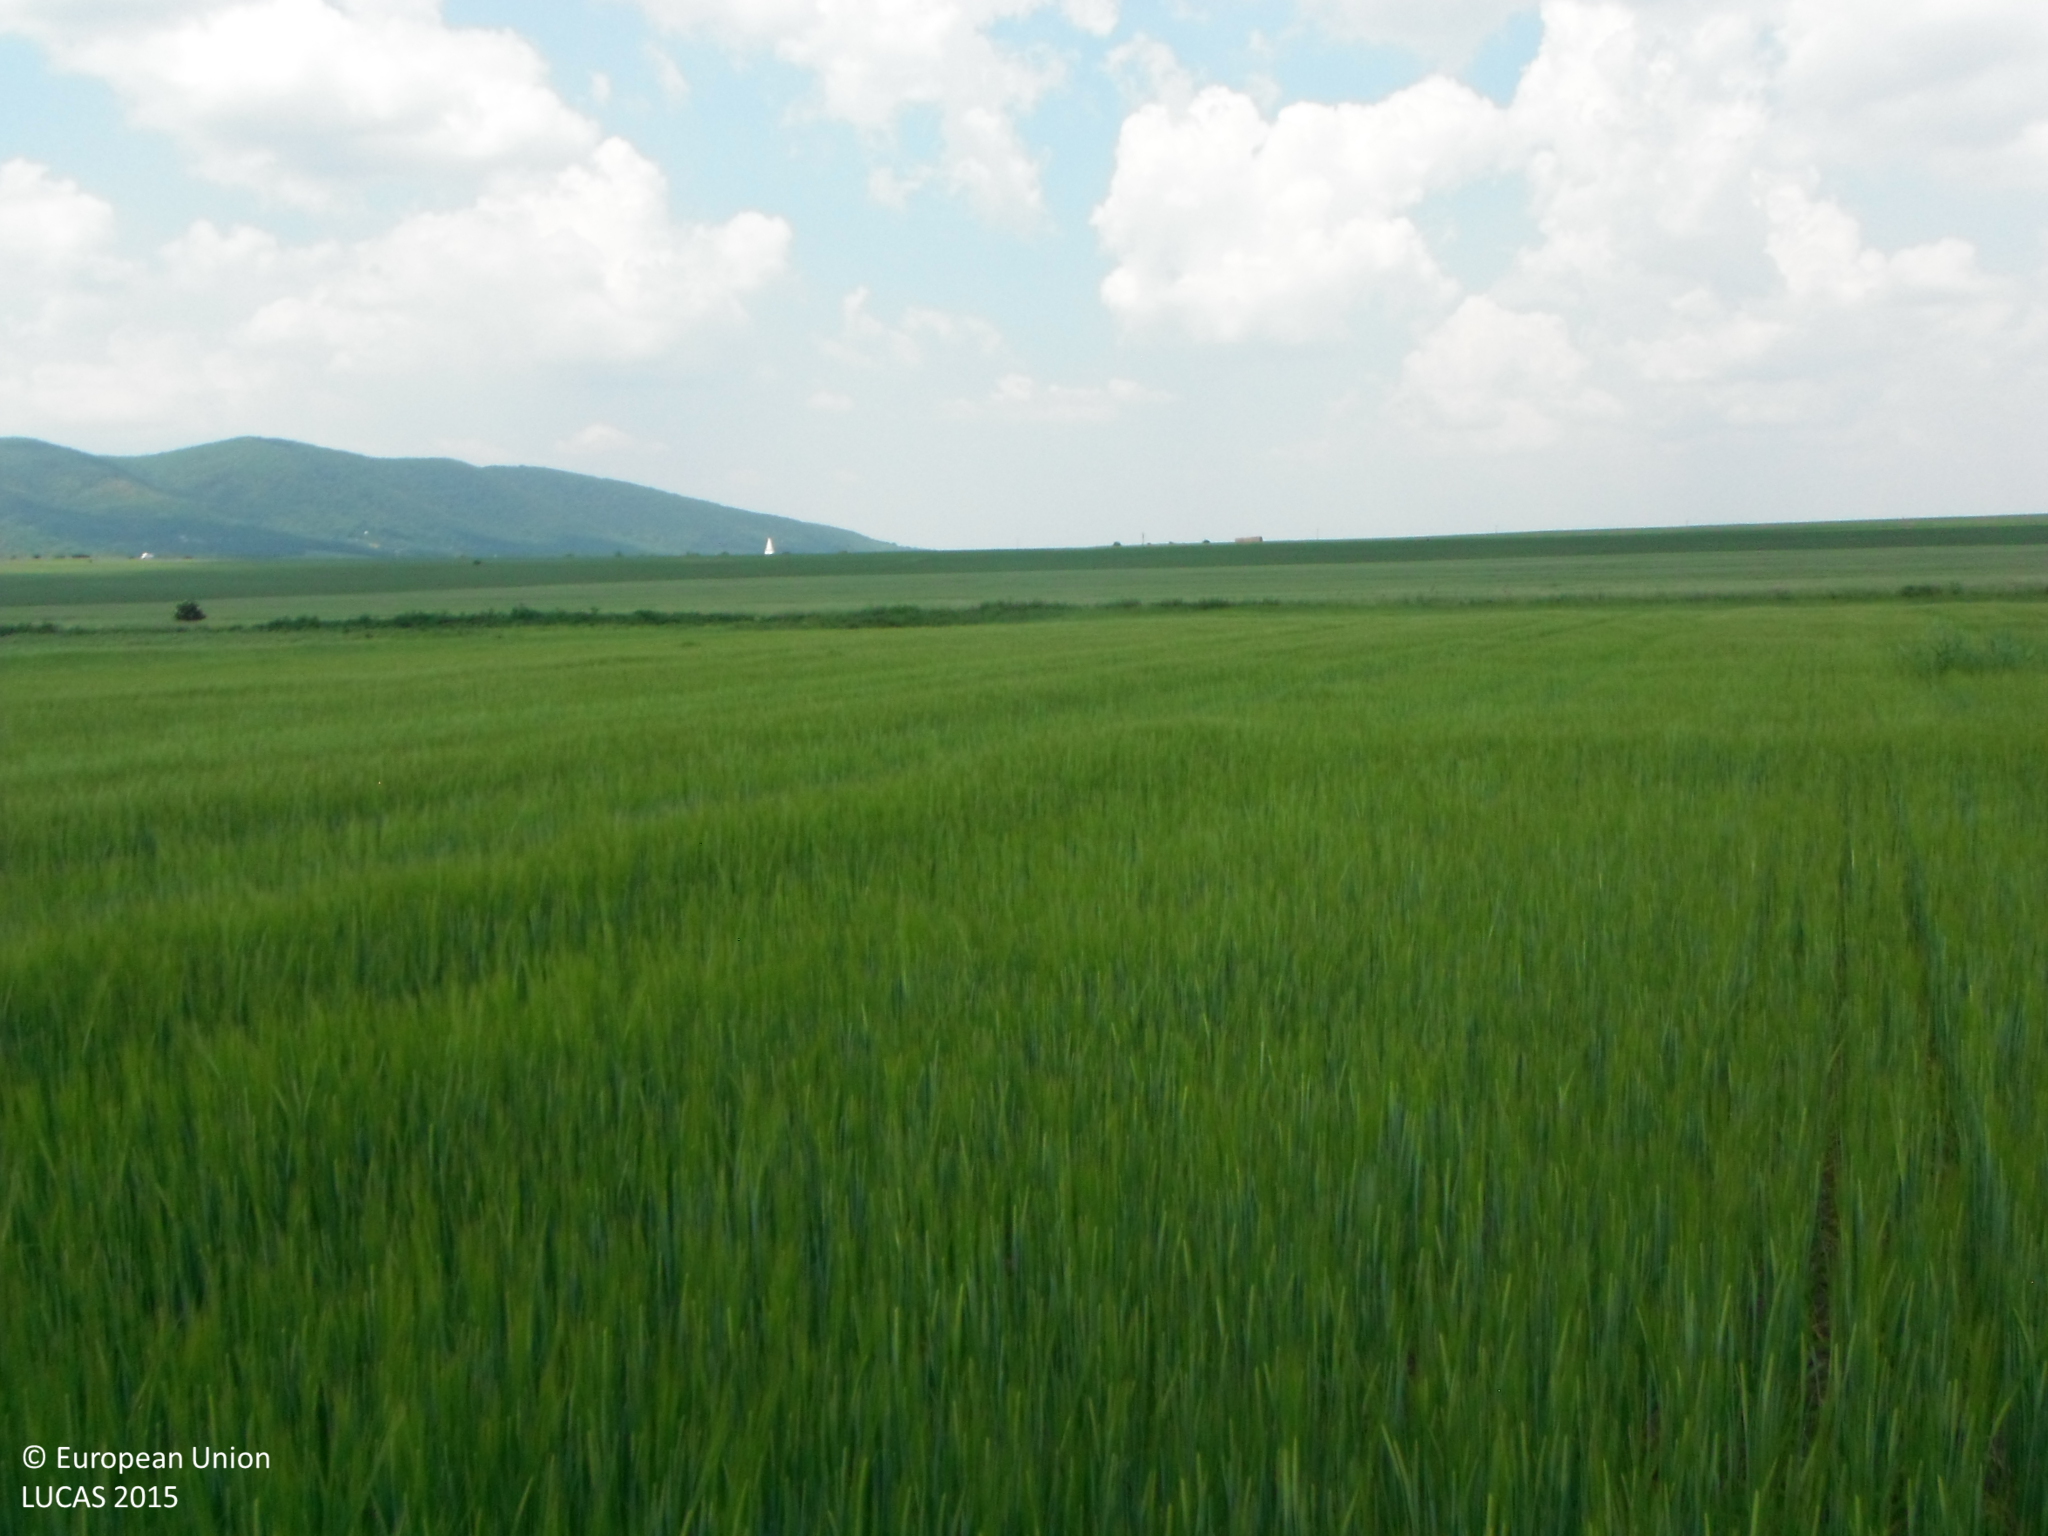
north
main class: Cropland
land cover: Barley
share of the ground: > 75 %
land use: Agriculture (excluding fallow land and kitchen gardens)
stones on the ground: < 10 %
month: June
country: SK
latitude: 48.4244
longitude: 17.4291
